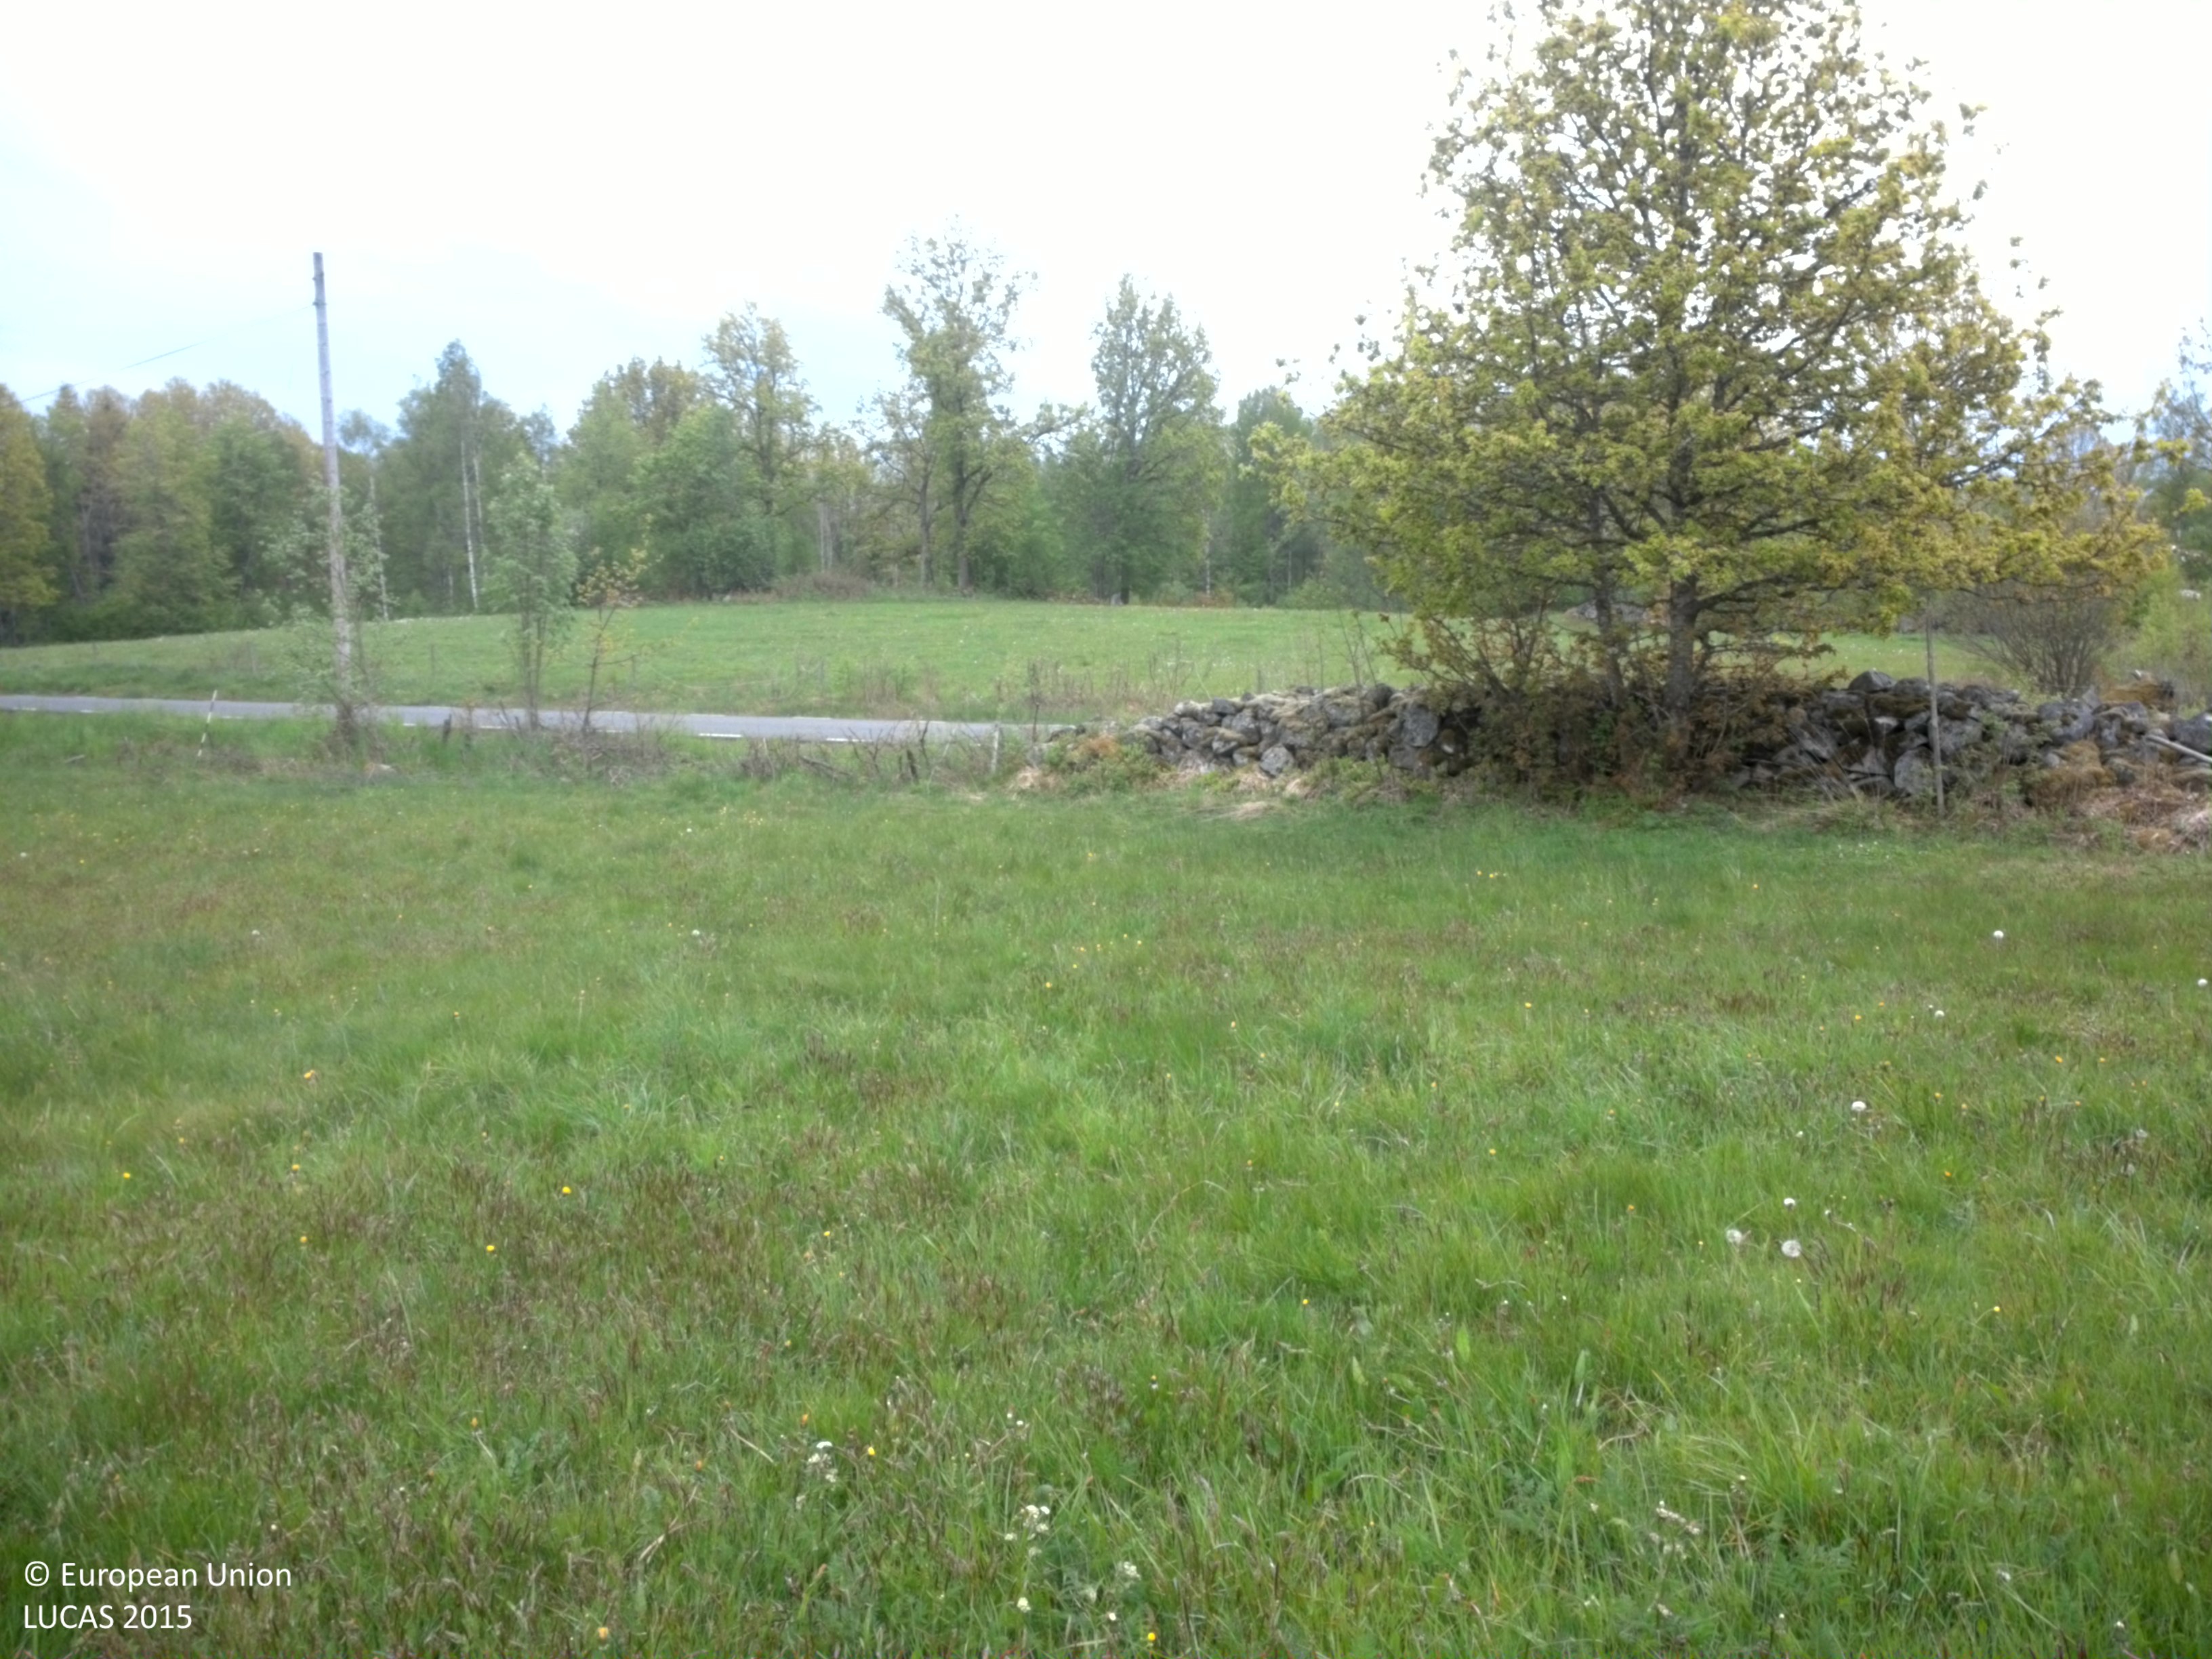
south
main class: Grassland
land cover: Grassland without tree/shrub cover
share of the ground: > 75 %
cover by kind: herbaceous plants 100 %
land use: Agriculture (excluding fallow land and kitchen gardens)
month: May
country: SE
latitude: 56.5706
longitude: 15.1576
